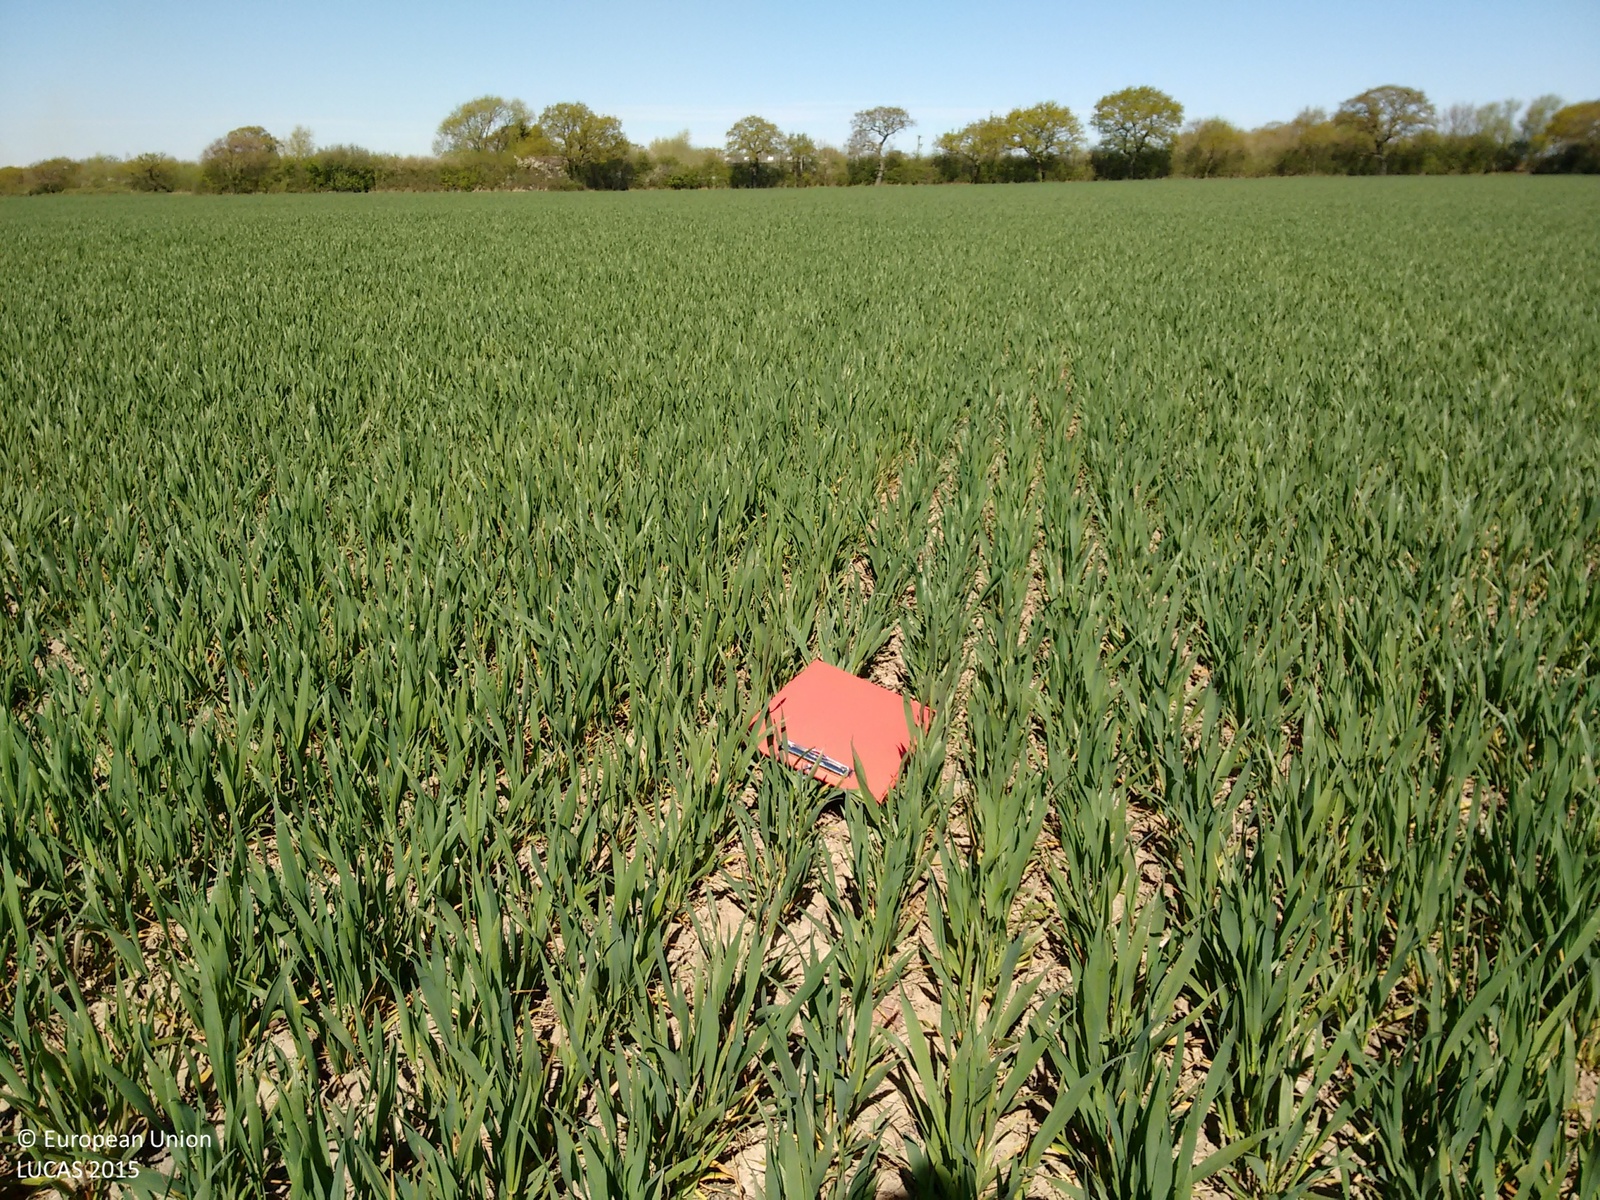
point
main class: Cropland
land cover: Common wheat
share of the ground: > 75 %
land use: Agriculture (excluding fallow land and kitchen gardens)
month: April
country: GB
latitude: 53.7855
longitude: -0.8322
